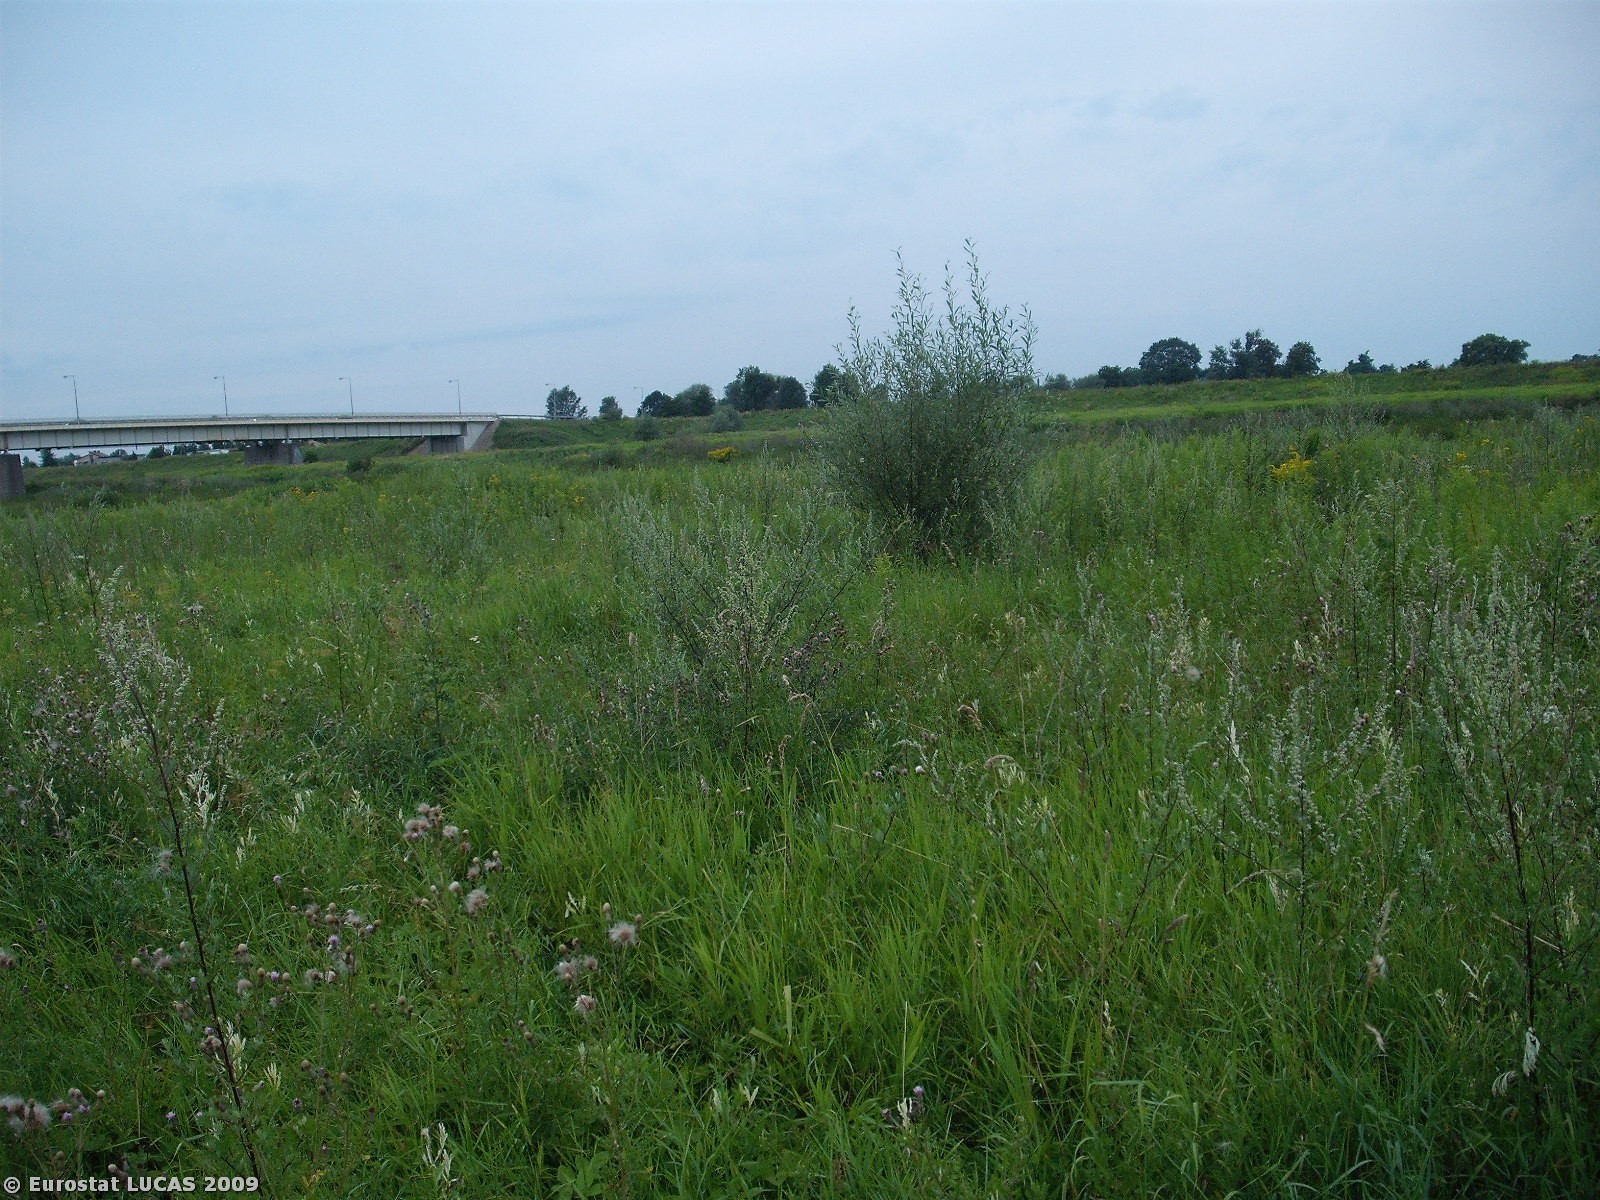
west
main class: Grassland
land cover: Grassland without tree/shrub cover
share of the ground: > 75 %
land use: Unused
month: July
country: PL
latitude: 50.0505
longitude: 20.2155
